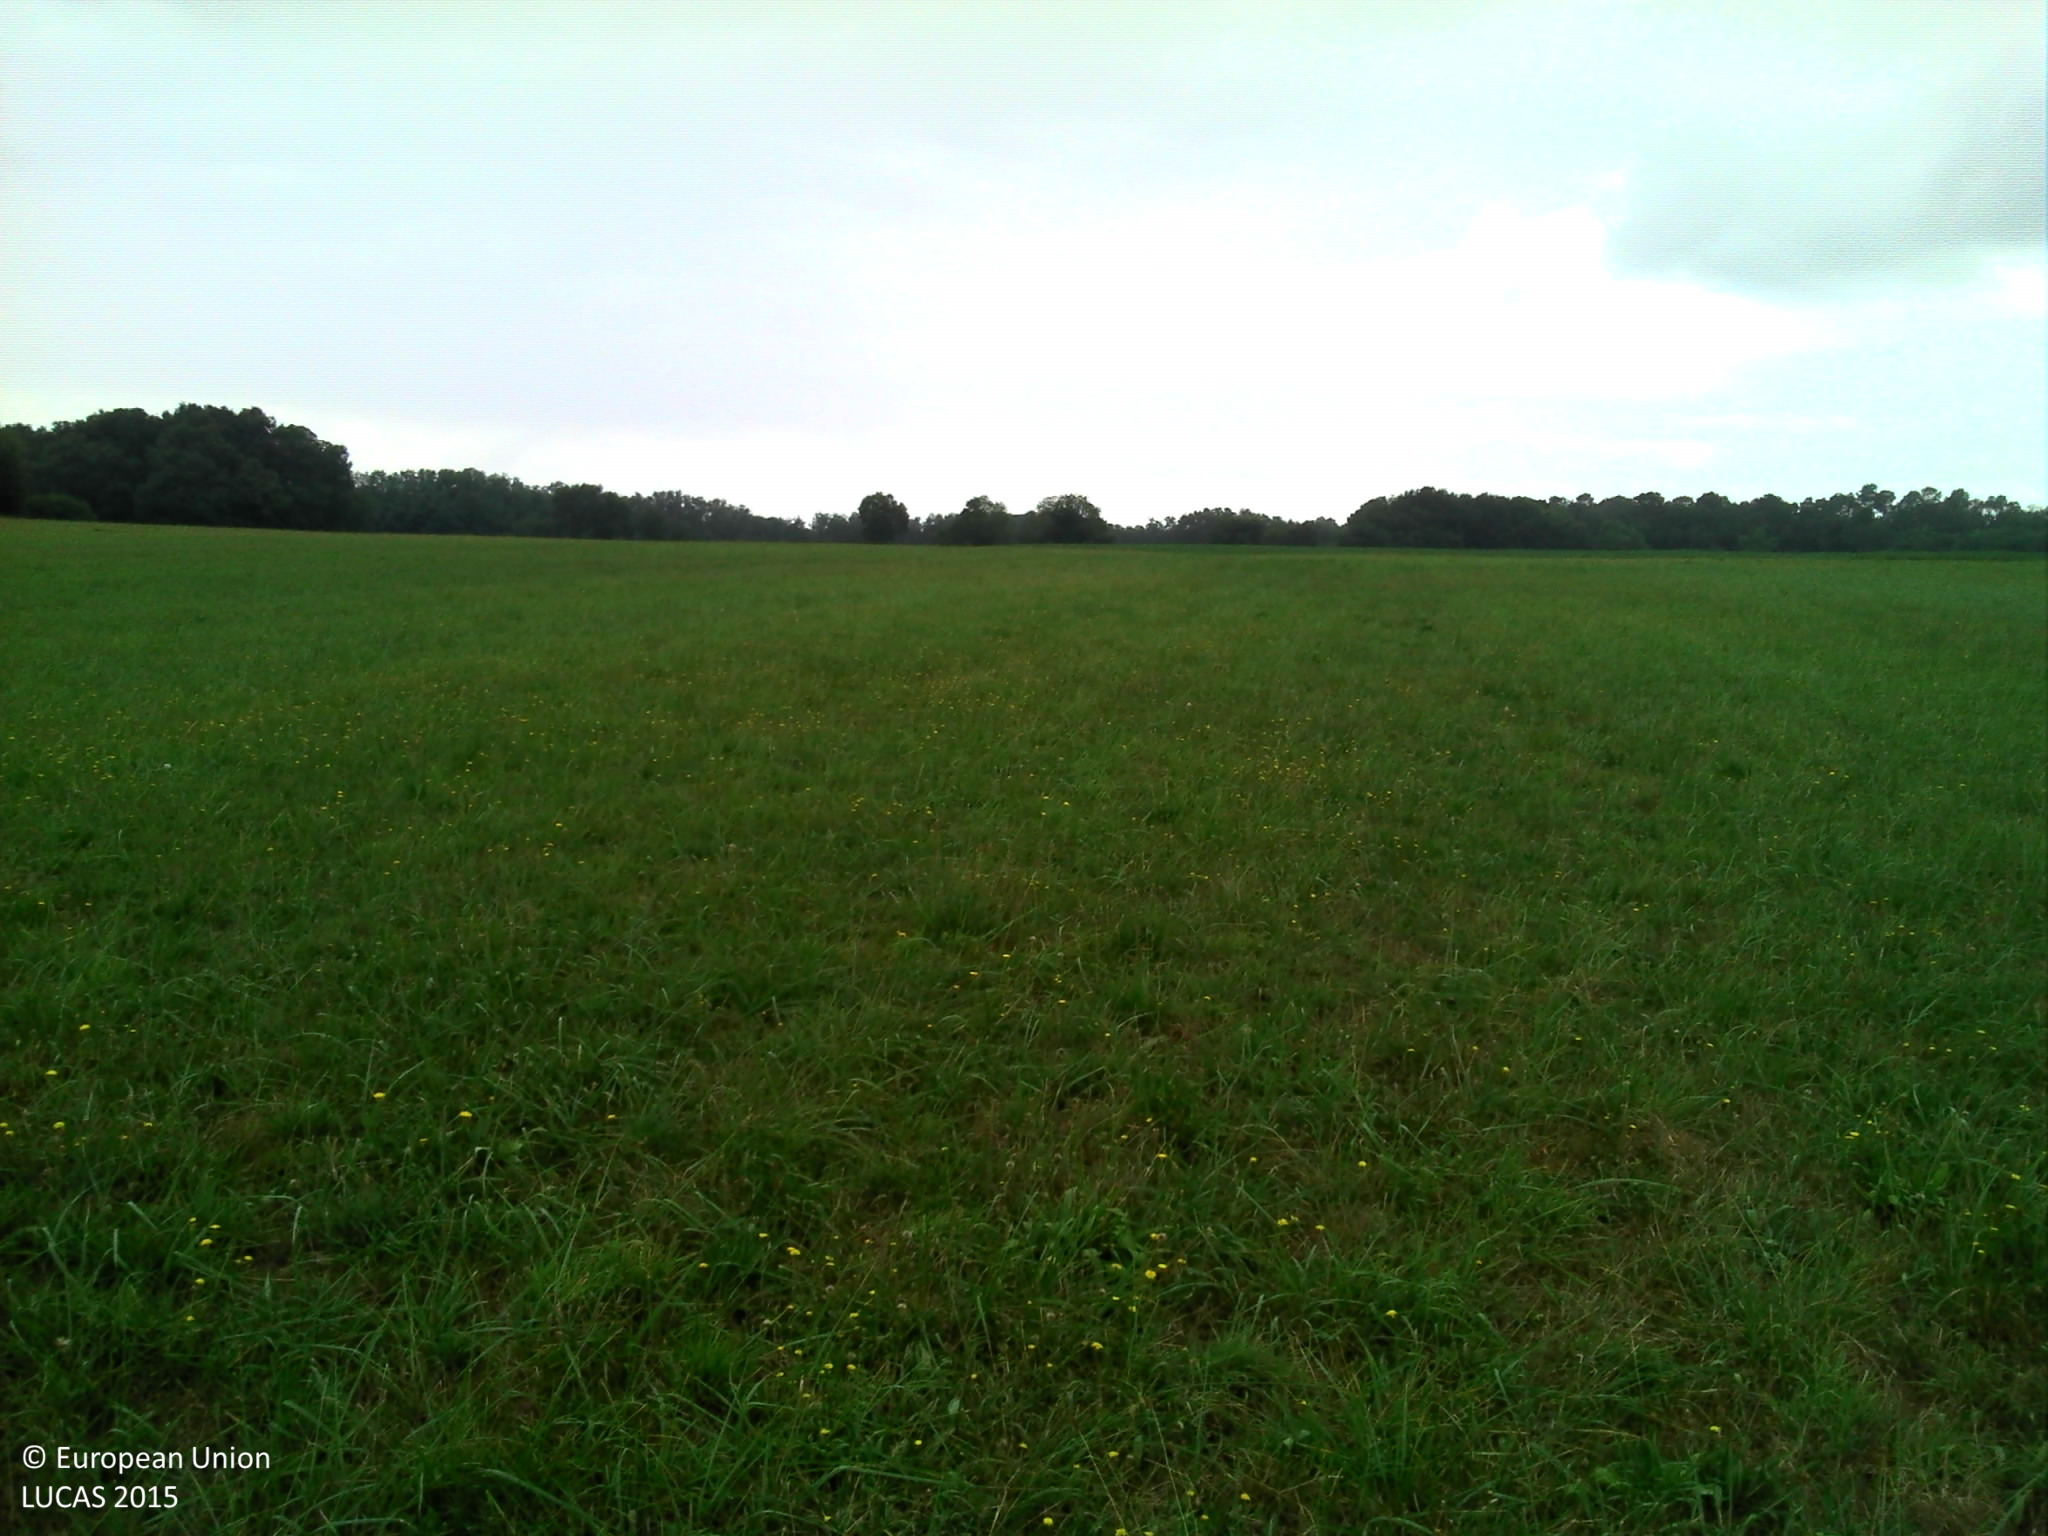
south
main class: Grassland
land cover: Grassland without tree/shrub cover
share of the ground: > 75 %
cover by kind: herbaceous plants 100 %
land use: Agriculture (excluding fallow land and kitchen gardens)
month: July
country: FR
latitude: 43.6321
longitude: -1.2089
